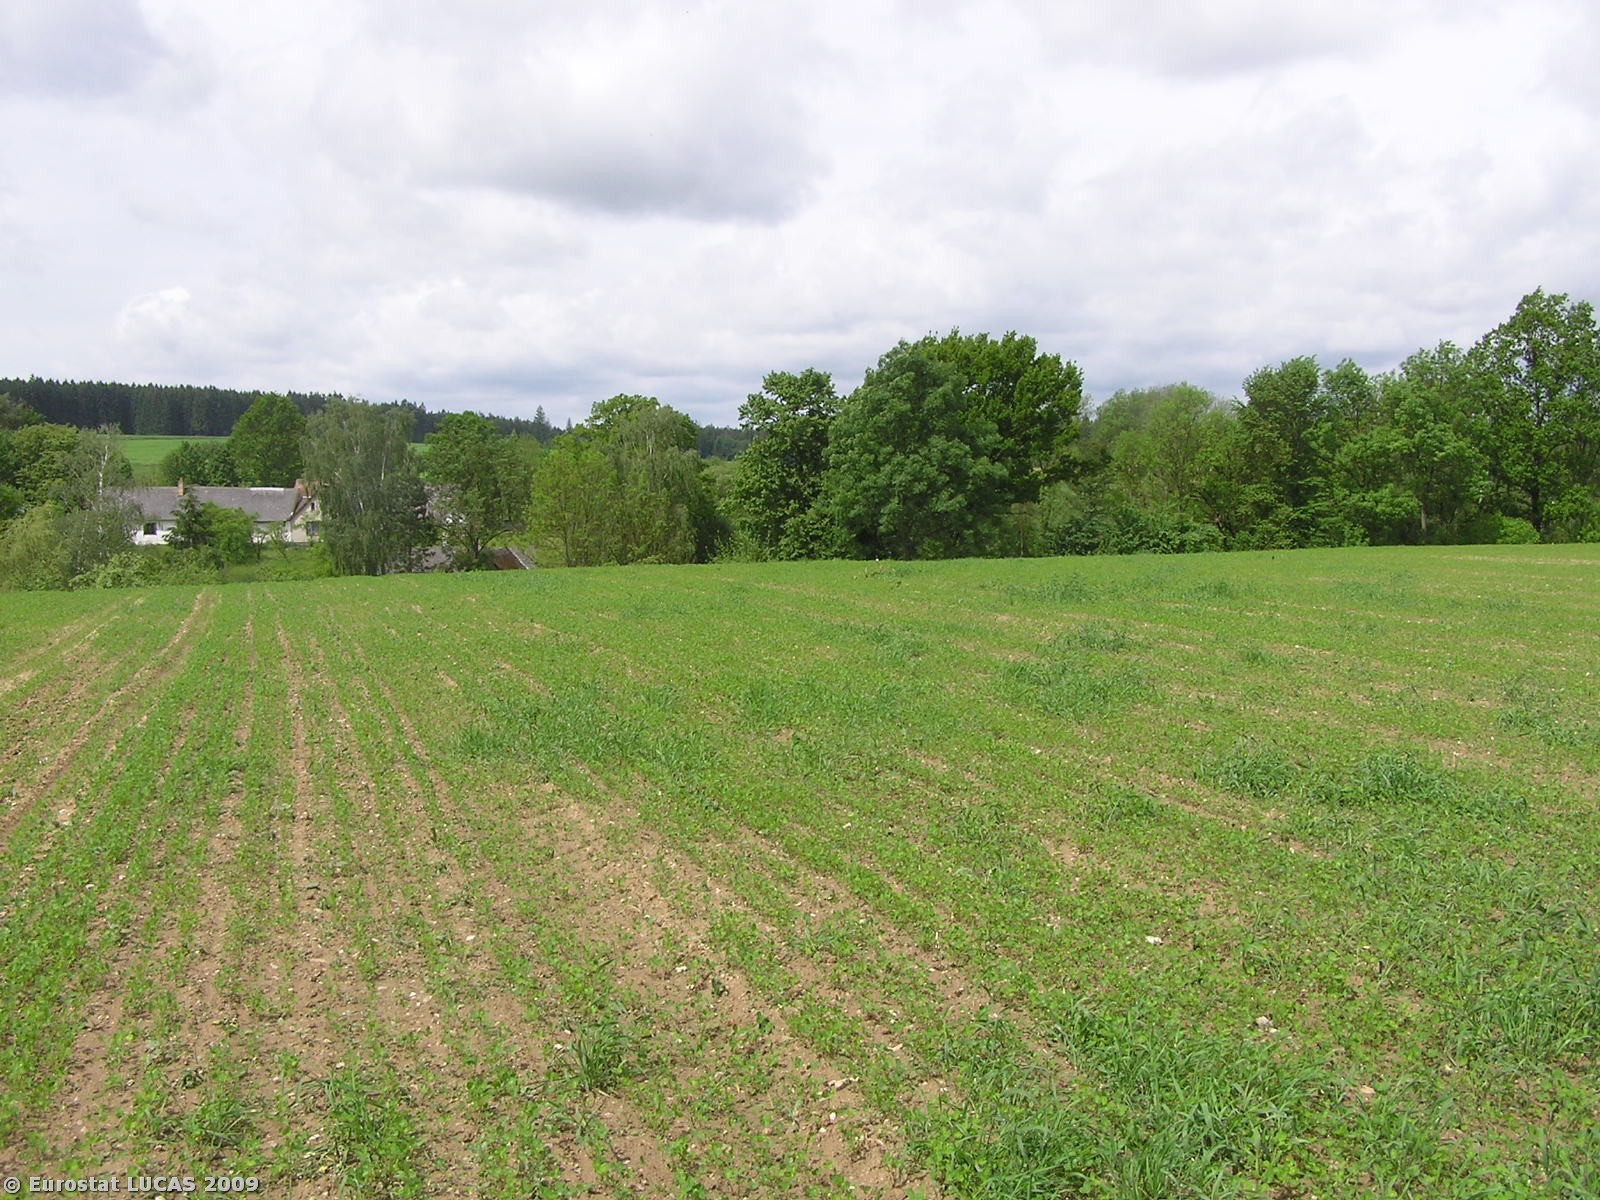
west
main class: Cropland
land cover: Clovers
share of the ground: 50 - 75 %
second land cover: Mixed cereals for fodder
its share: 25 - 50 %
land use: Agriculture (excluding fallow land and kitchen gardens)
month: May
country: CZ
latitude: 49.4089
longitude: 14.9778
